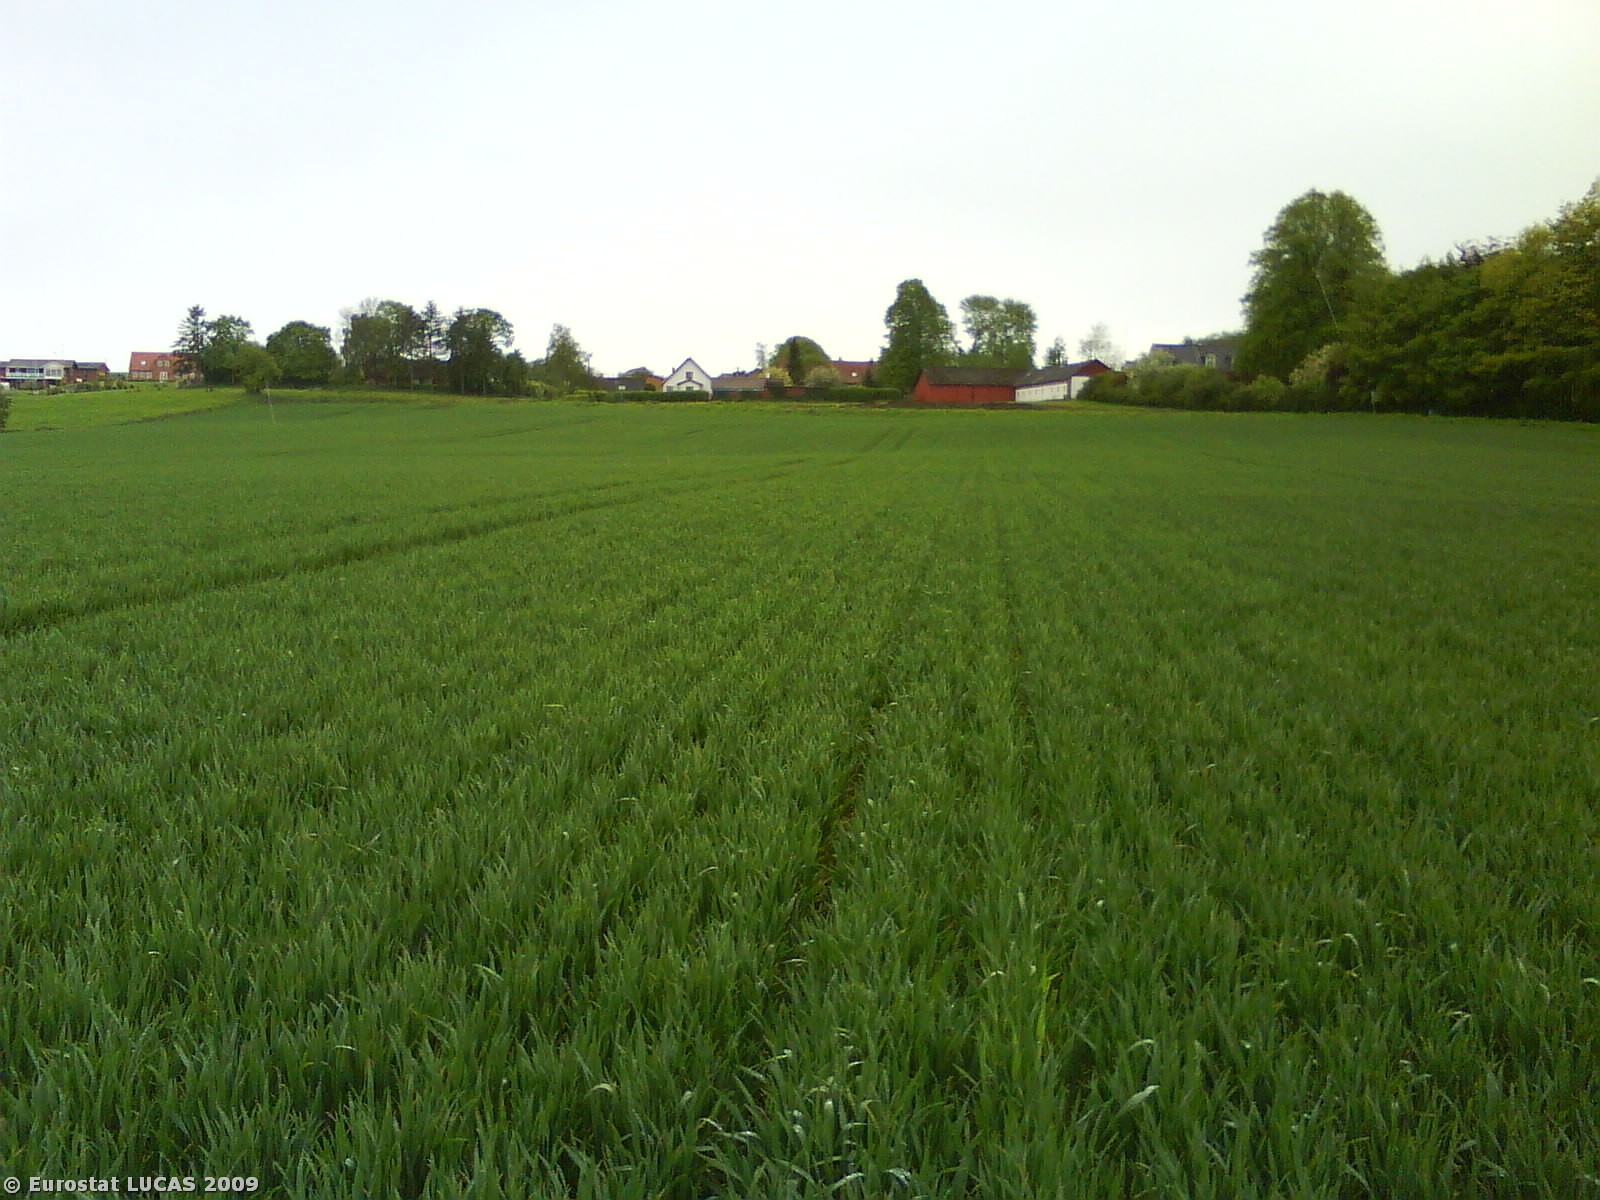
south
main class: Cropland
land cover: Common wheat
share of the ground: > 75 %
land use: Agriculture (excluding fallow land and kitchen gardens)
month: May
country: DK
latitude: 56.3674
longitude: 10.1455
